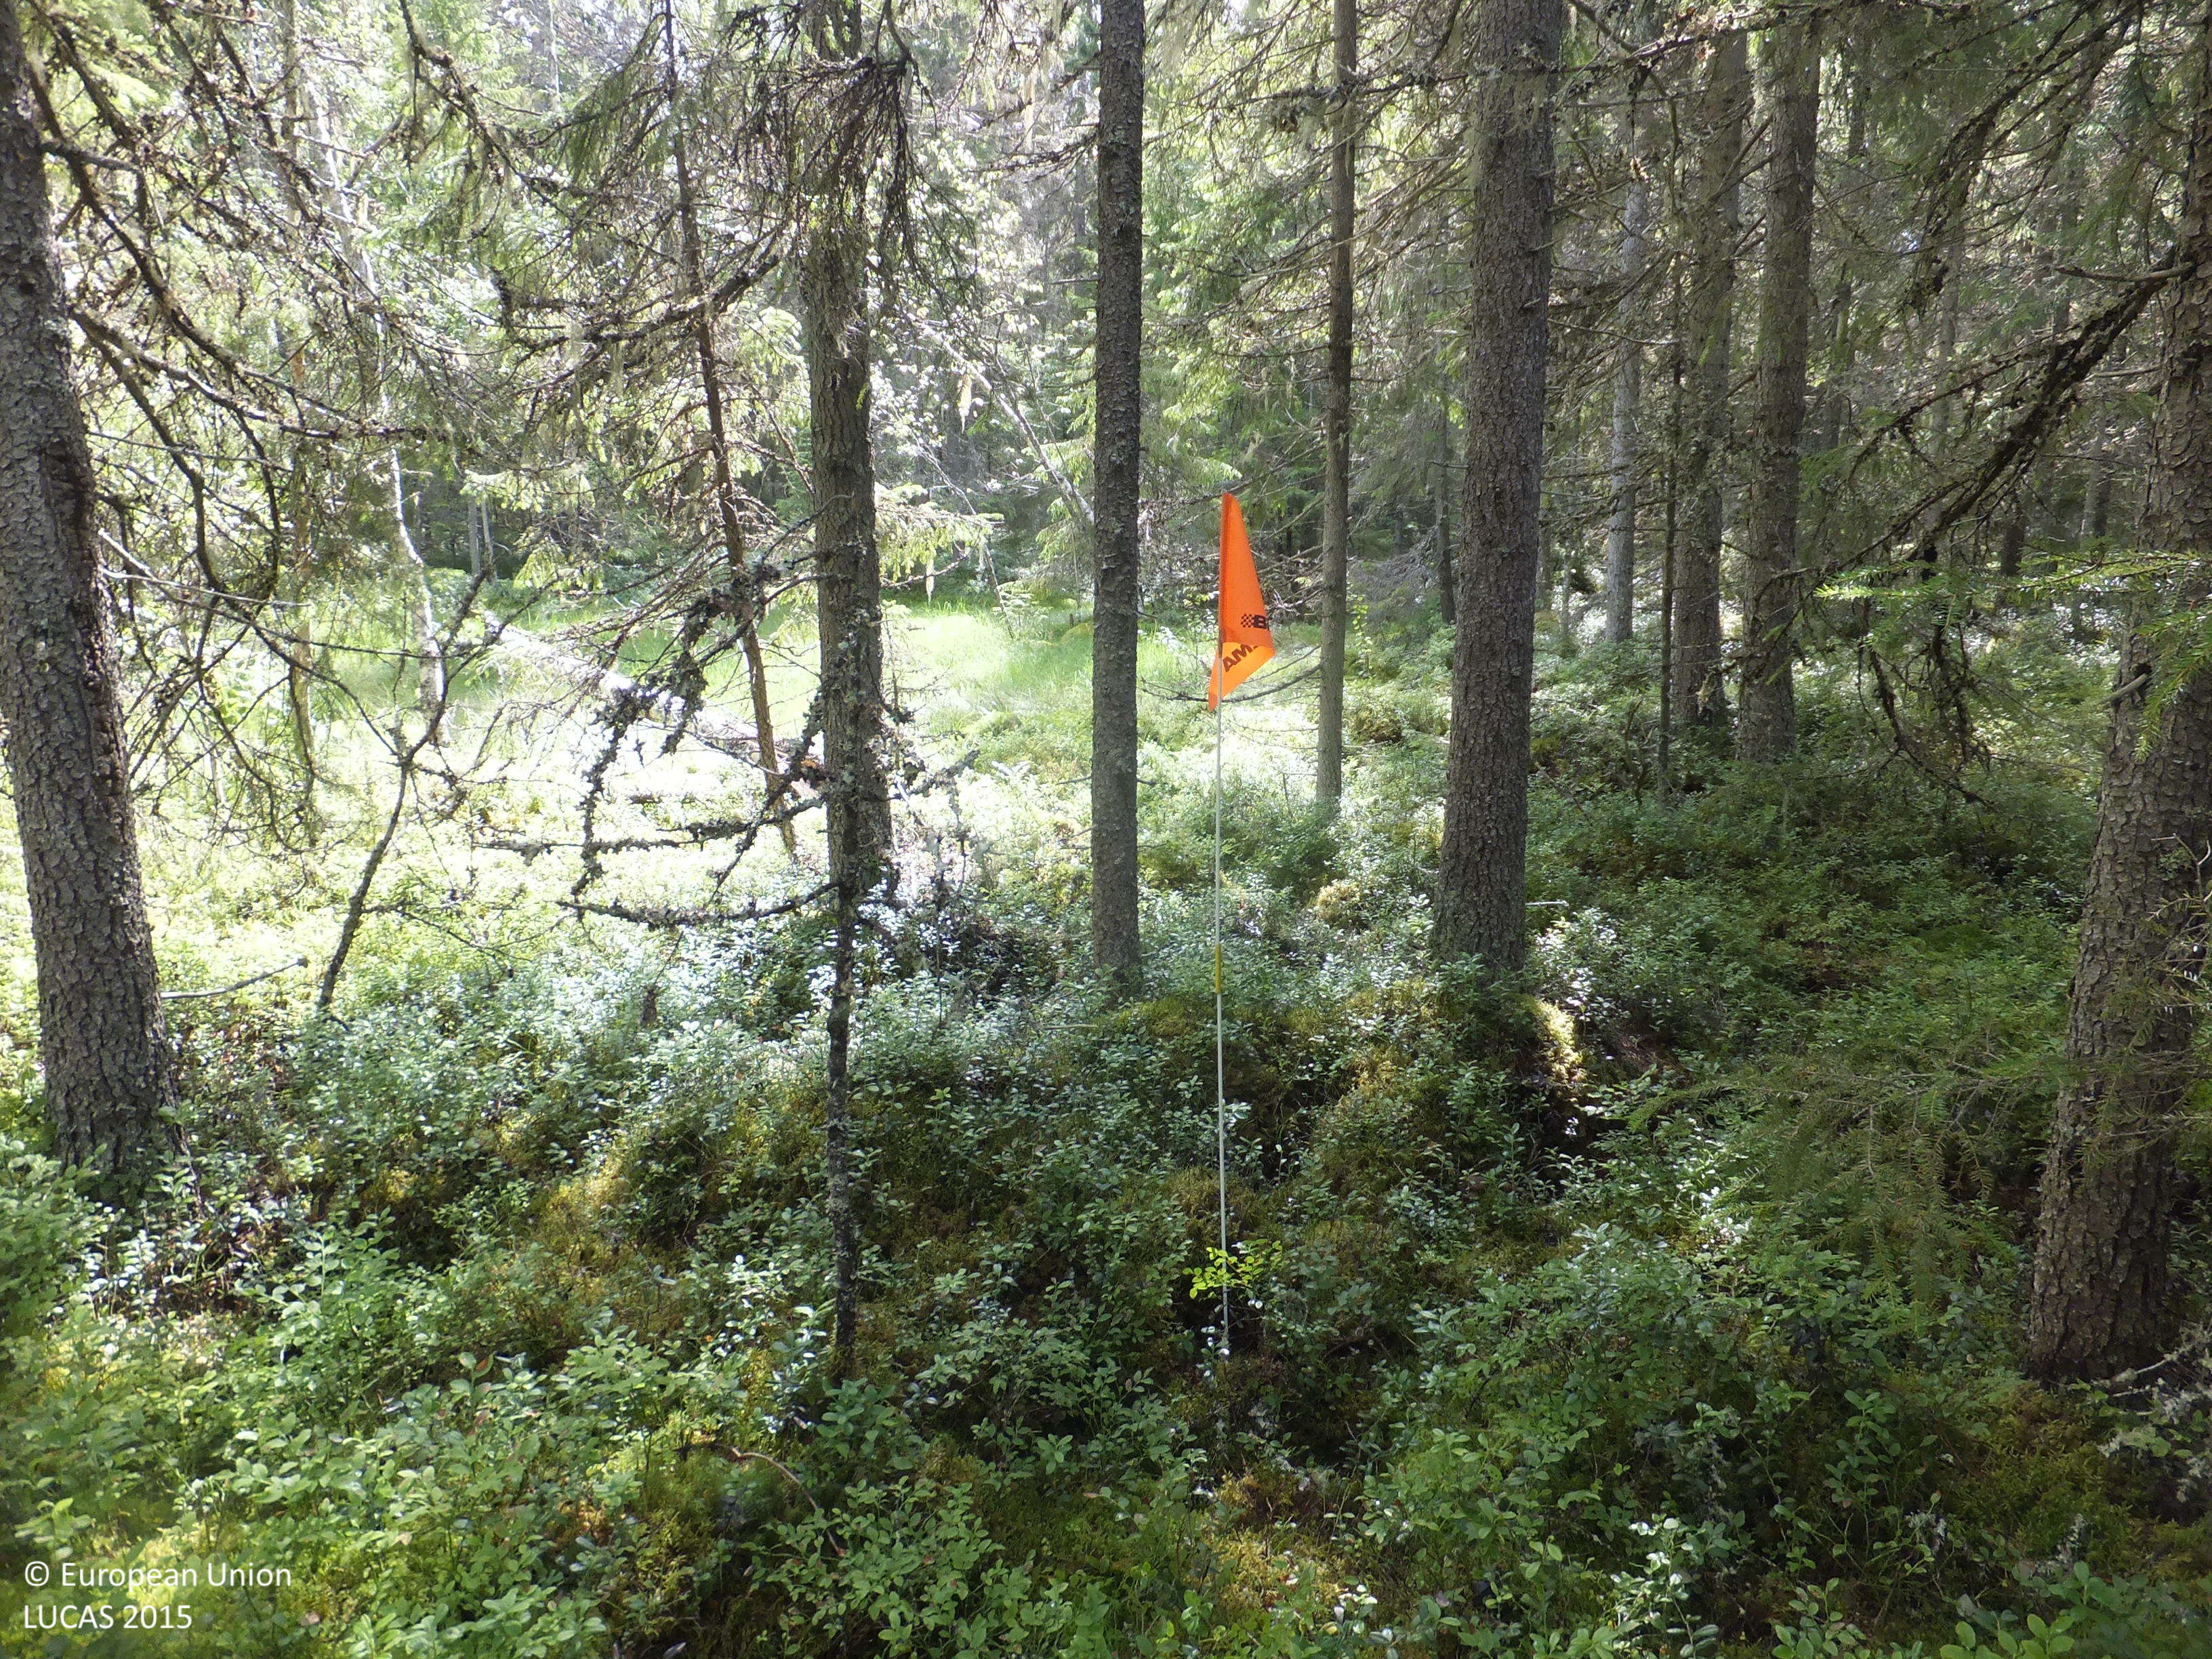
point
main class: Woodland
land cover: Spruce dominated coniferous woodland
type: boreal forest
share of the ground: 50 - 75 %
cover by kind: coniferous forest trees 65 %, shrubs 15 %, lichens and mosses 10 %, broadleaved forest trees 5 %, herbaceous plants 5 %
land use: Forestry
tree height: > 5 m
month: July
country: FI
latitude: 63.2743
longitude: 22.1023
